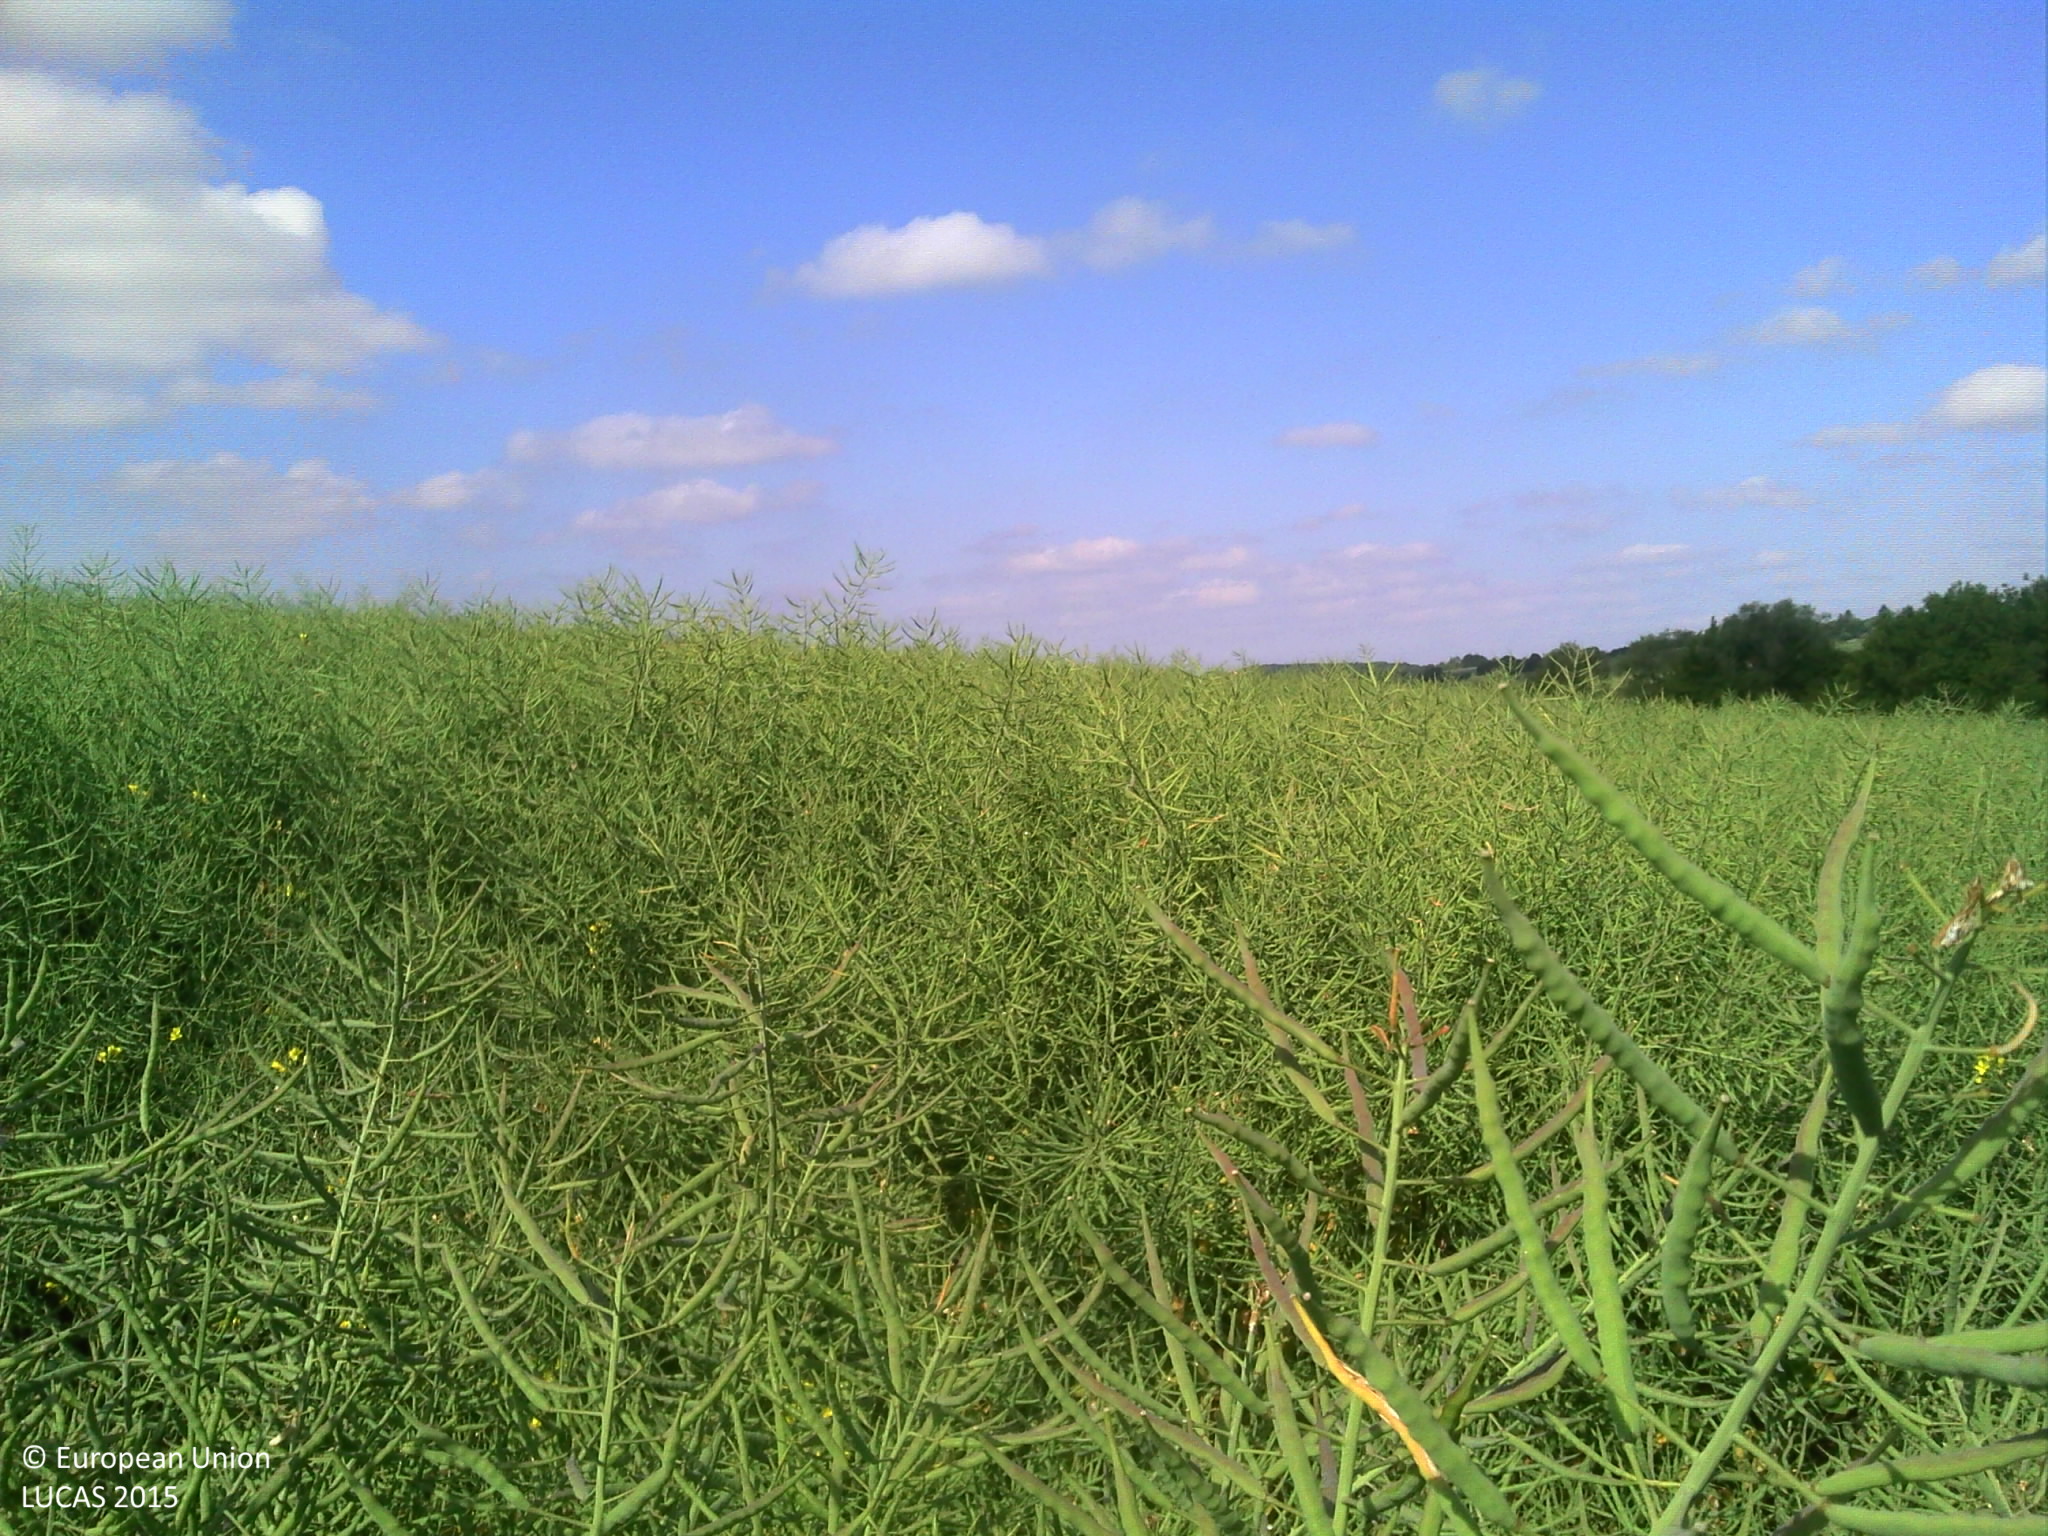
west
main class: Cropland
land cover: Rape and turnip rape
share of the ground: > 75 %
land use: Agriculture (excluding fallow land and kitchen gardens)
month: June
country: BE
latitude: 50.4017
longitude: 4.6641
